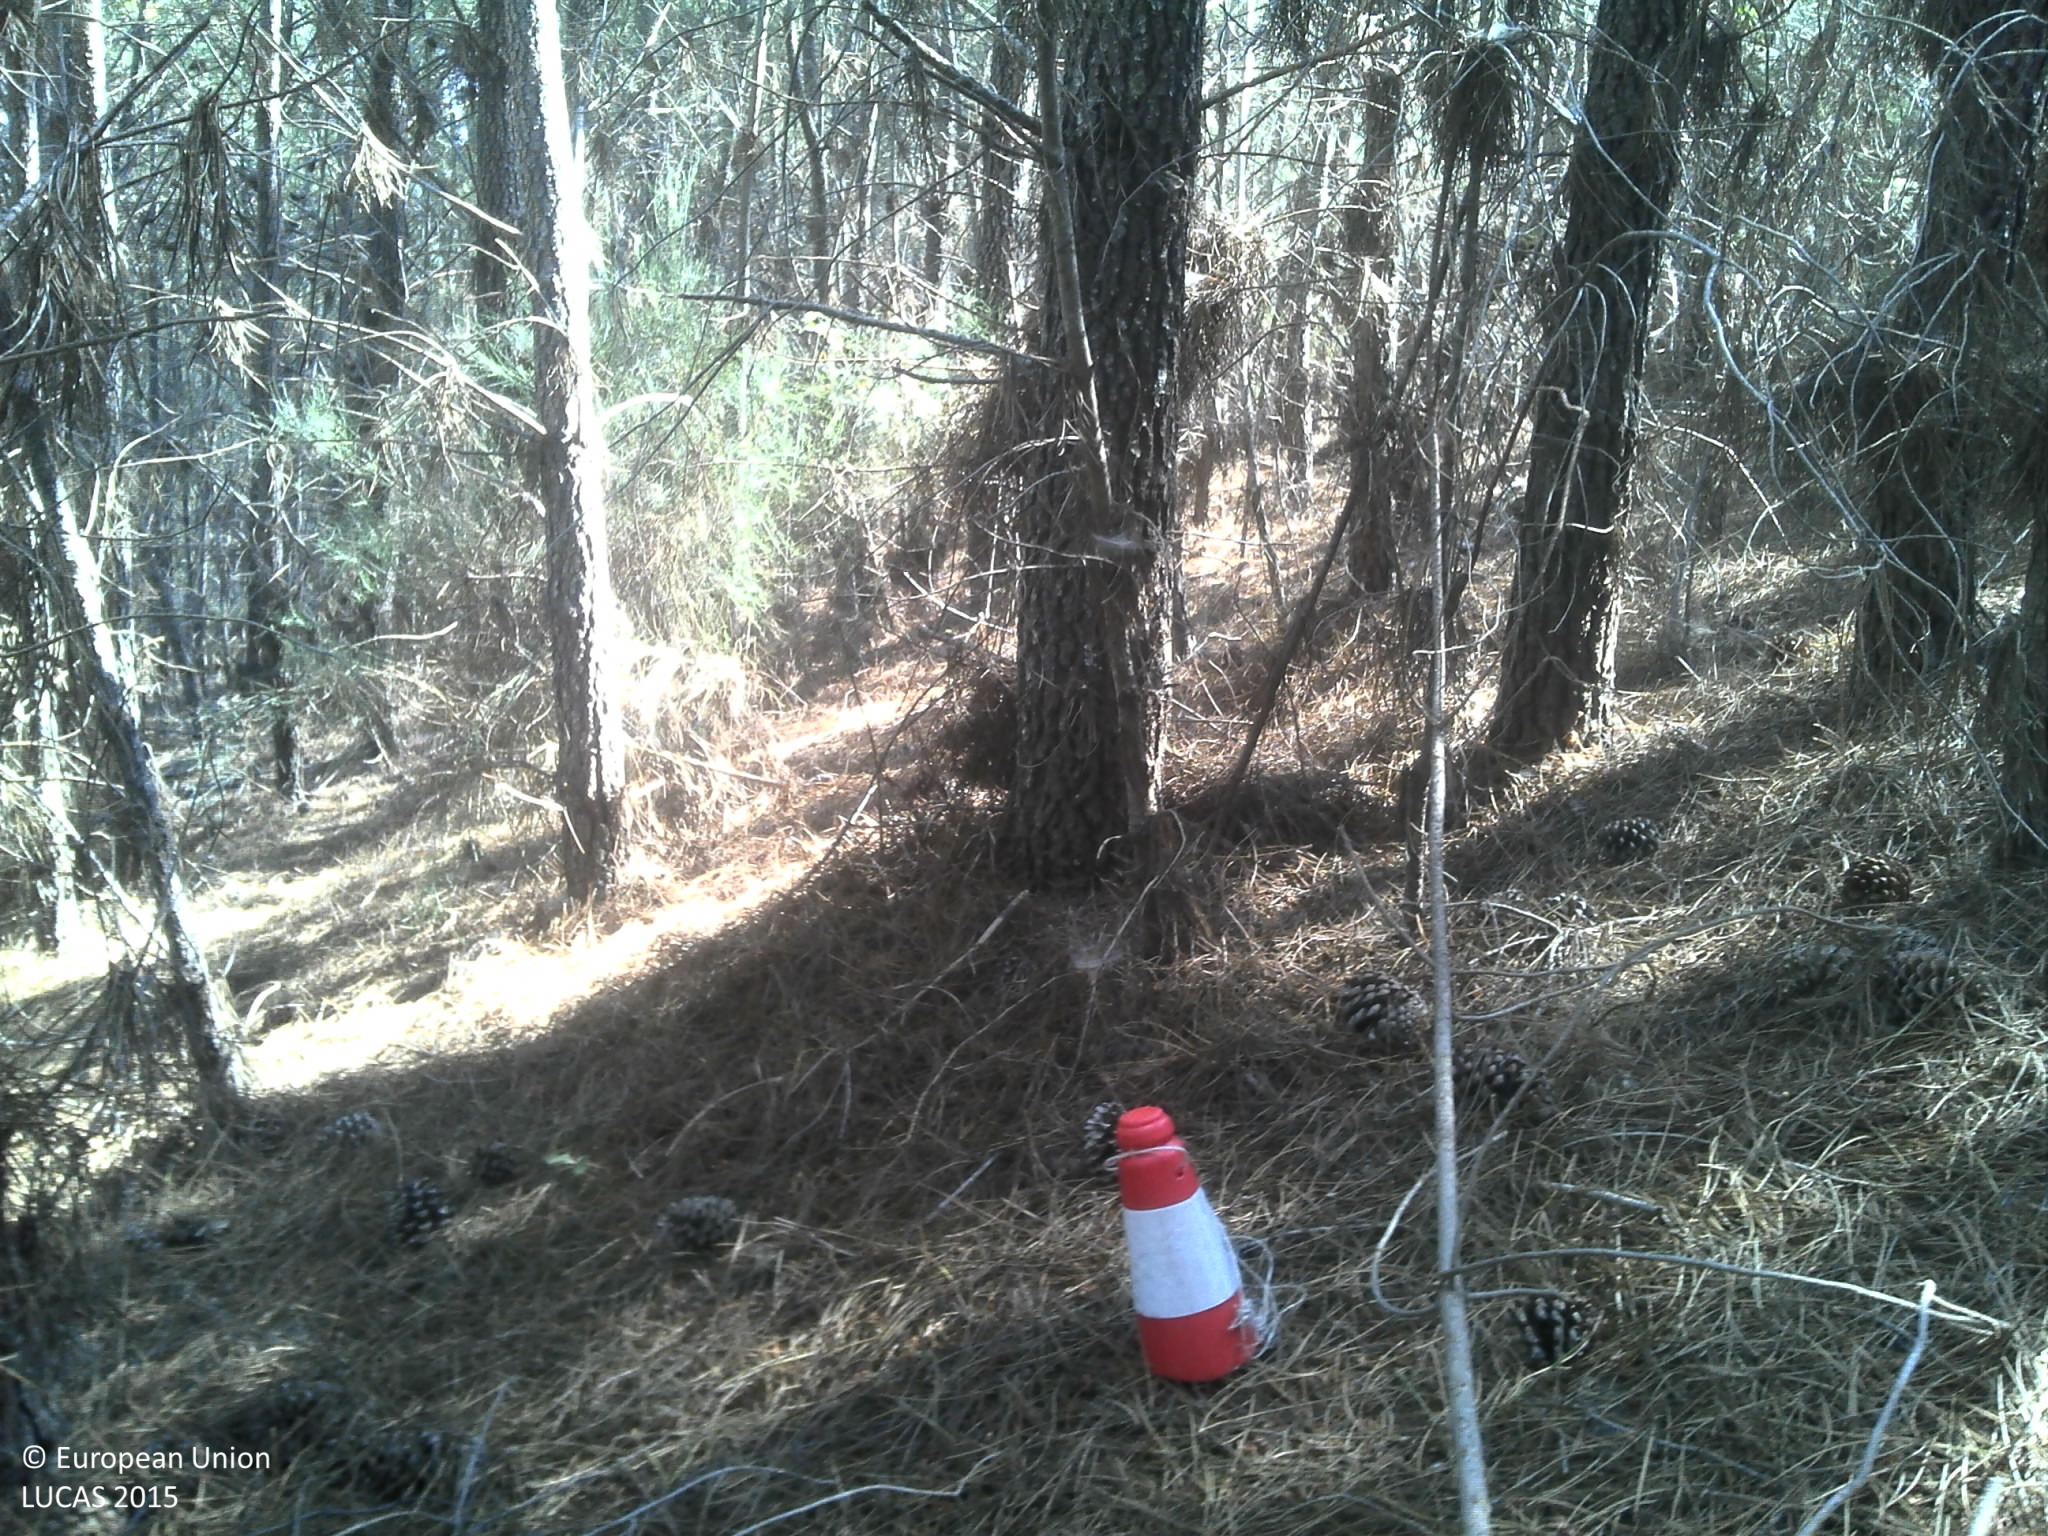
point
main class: Woodland
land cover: Pine dominated coniferous woodland
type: coniferous forest of the mediterranean region
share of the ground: > 75 %
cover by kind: coniferous forest trees 75 %, shrubs 15 %, unconsolidated bare surface 5 %
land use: Forestry
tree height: > 5 m
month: June
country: PT
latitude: 40.2987
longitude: -7.1218
